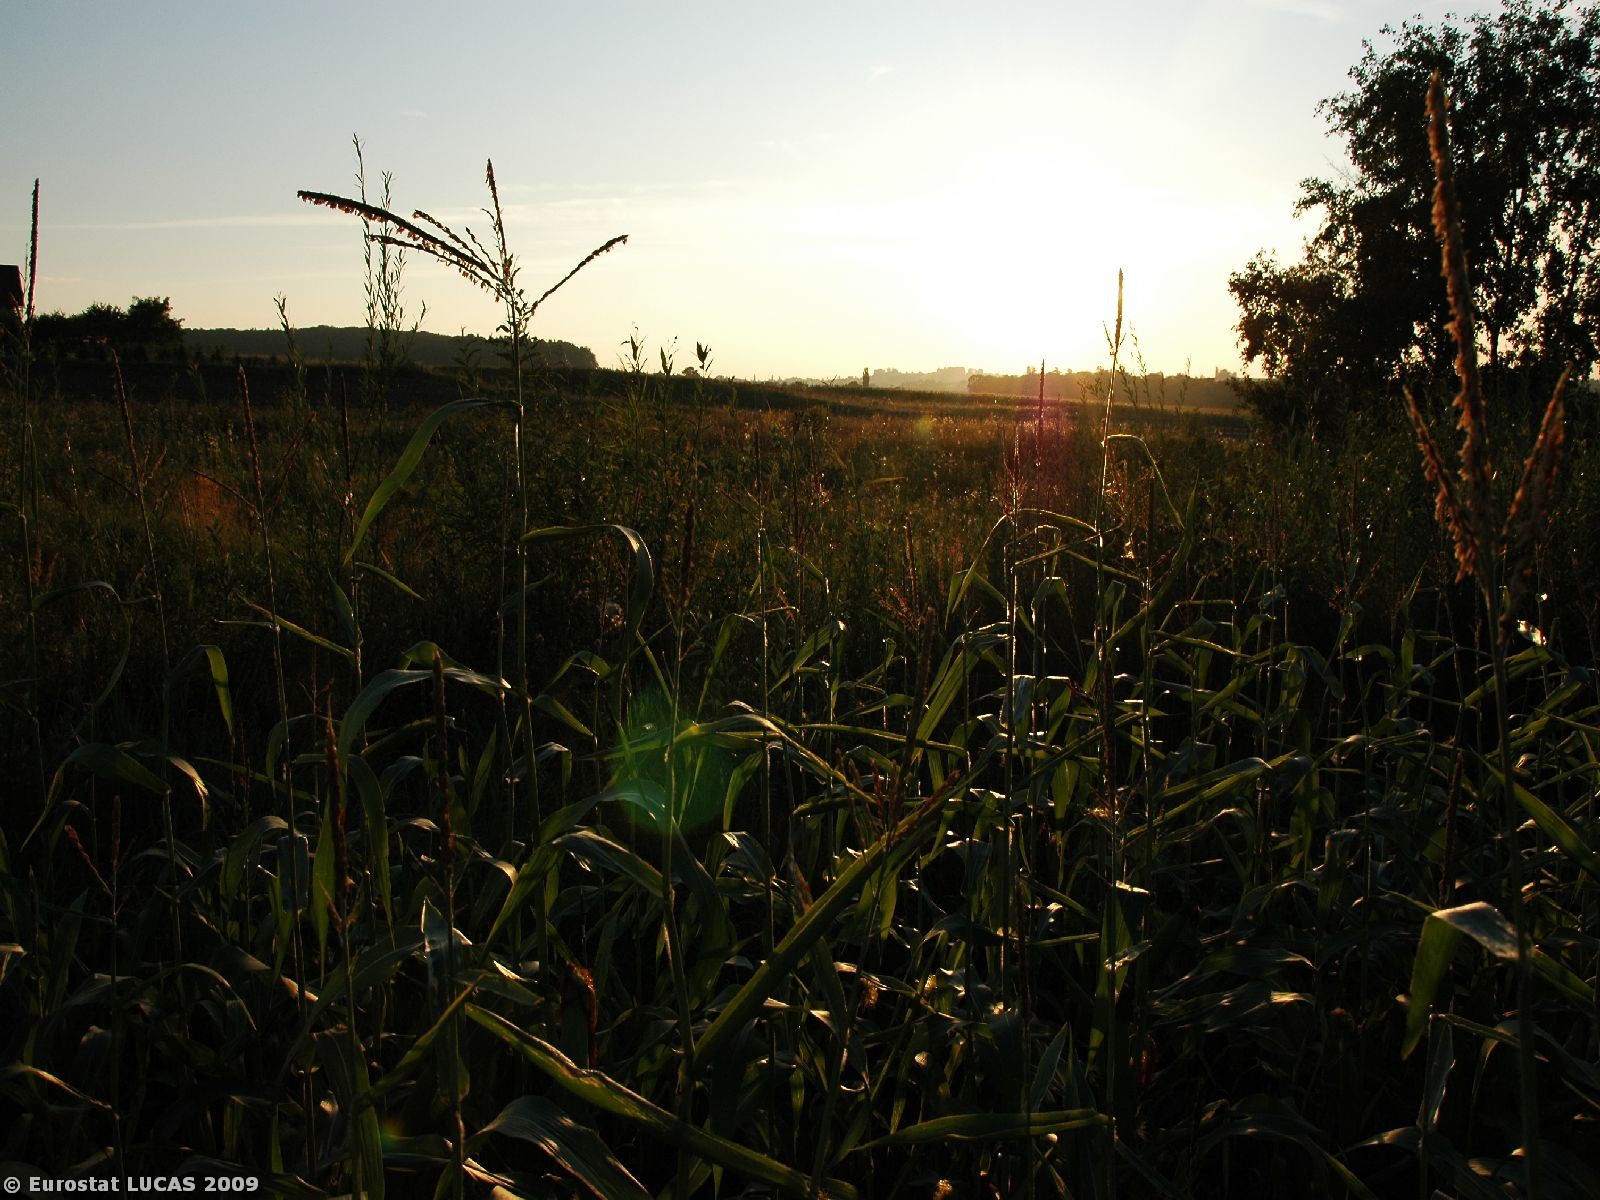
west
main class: Cropland
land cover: Maize
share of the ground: > 75 %
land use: Agriculture (excluding fallow land and kitchen gardens)
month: August
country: PL
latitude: 49.7767
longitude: 18.7274
